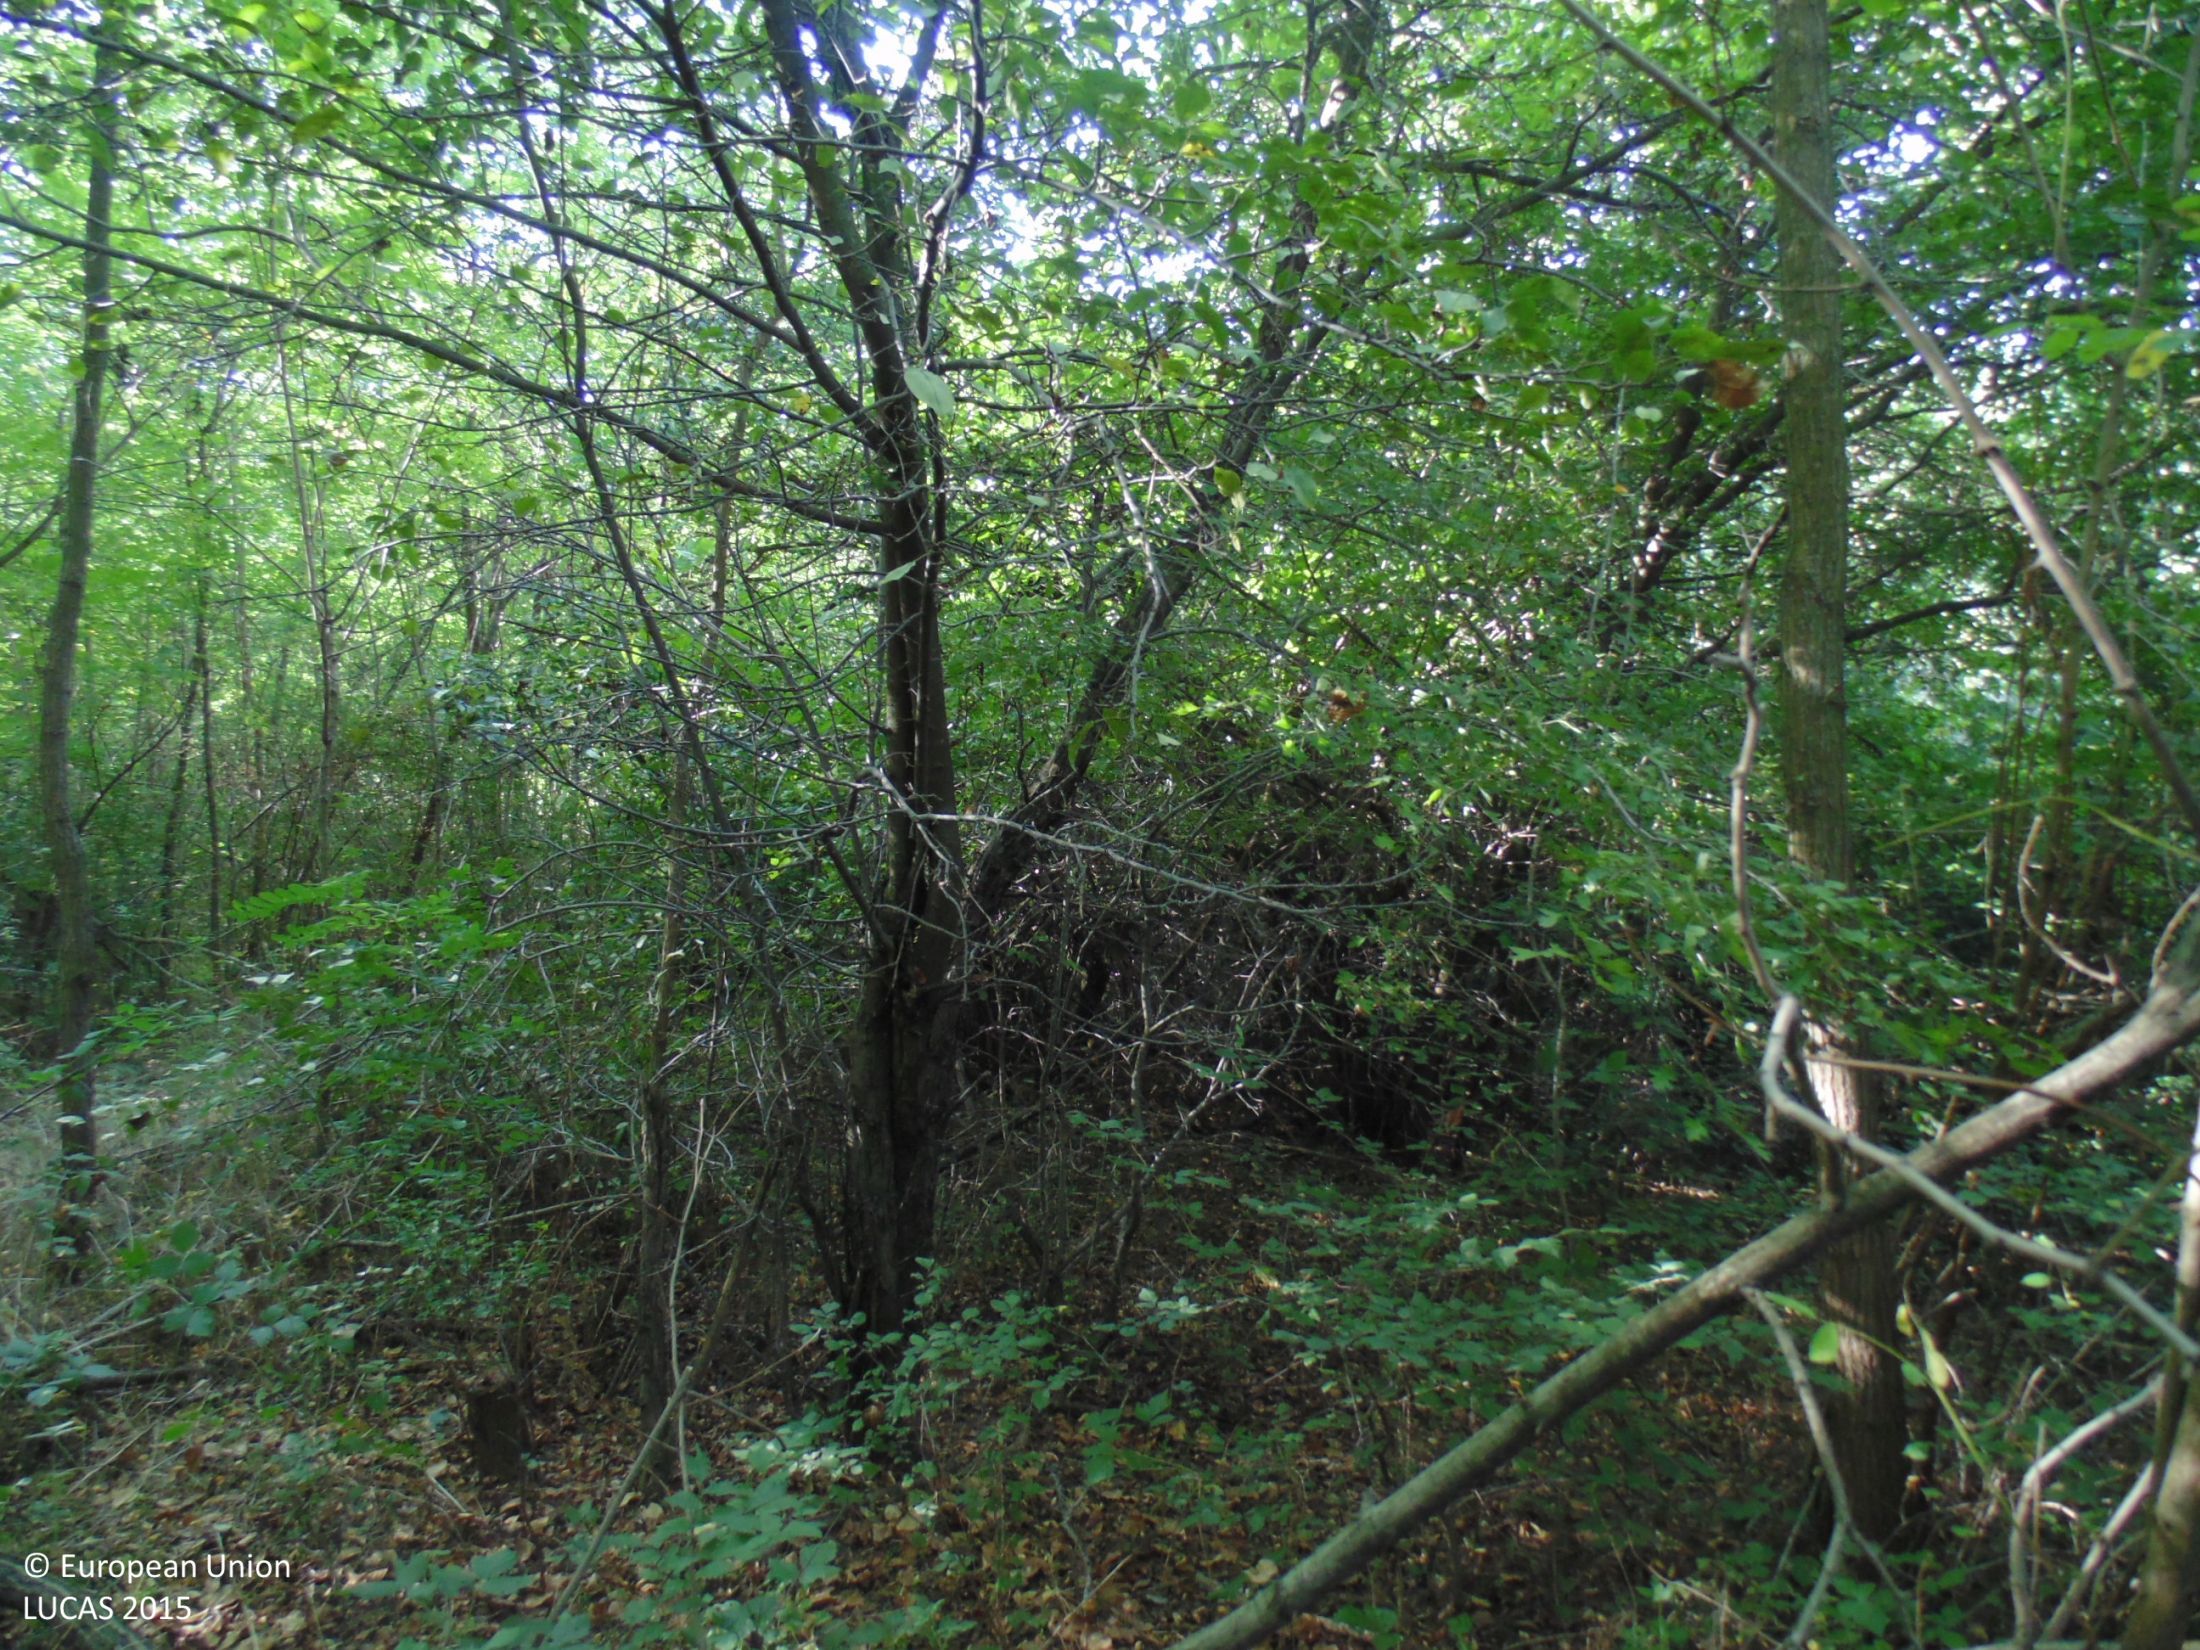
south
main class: Woodland
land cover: Broadleaved woodland
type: mesophytic deciduous forest
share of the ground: > 75 %
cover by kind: broadleaved forest trees 90 %, shrubs 5 %, unconsolidated bare surface 5 %
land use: Forestry
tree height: > 5 m
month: September
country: BG
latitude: 43.8384
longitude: 27.1009
